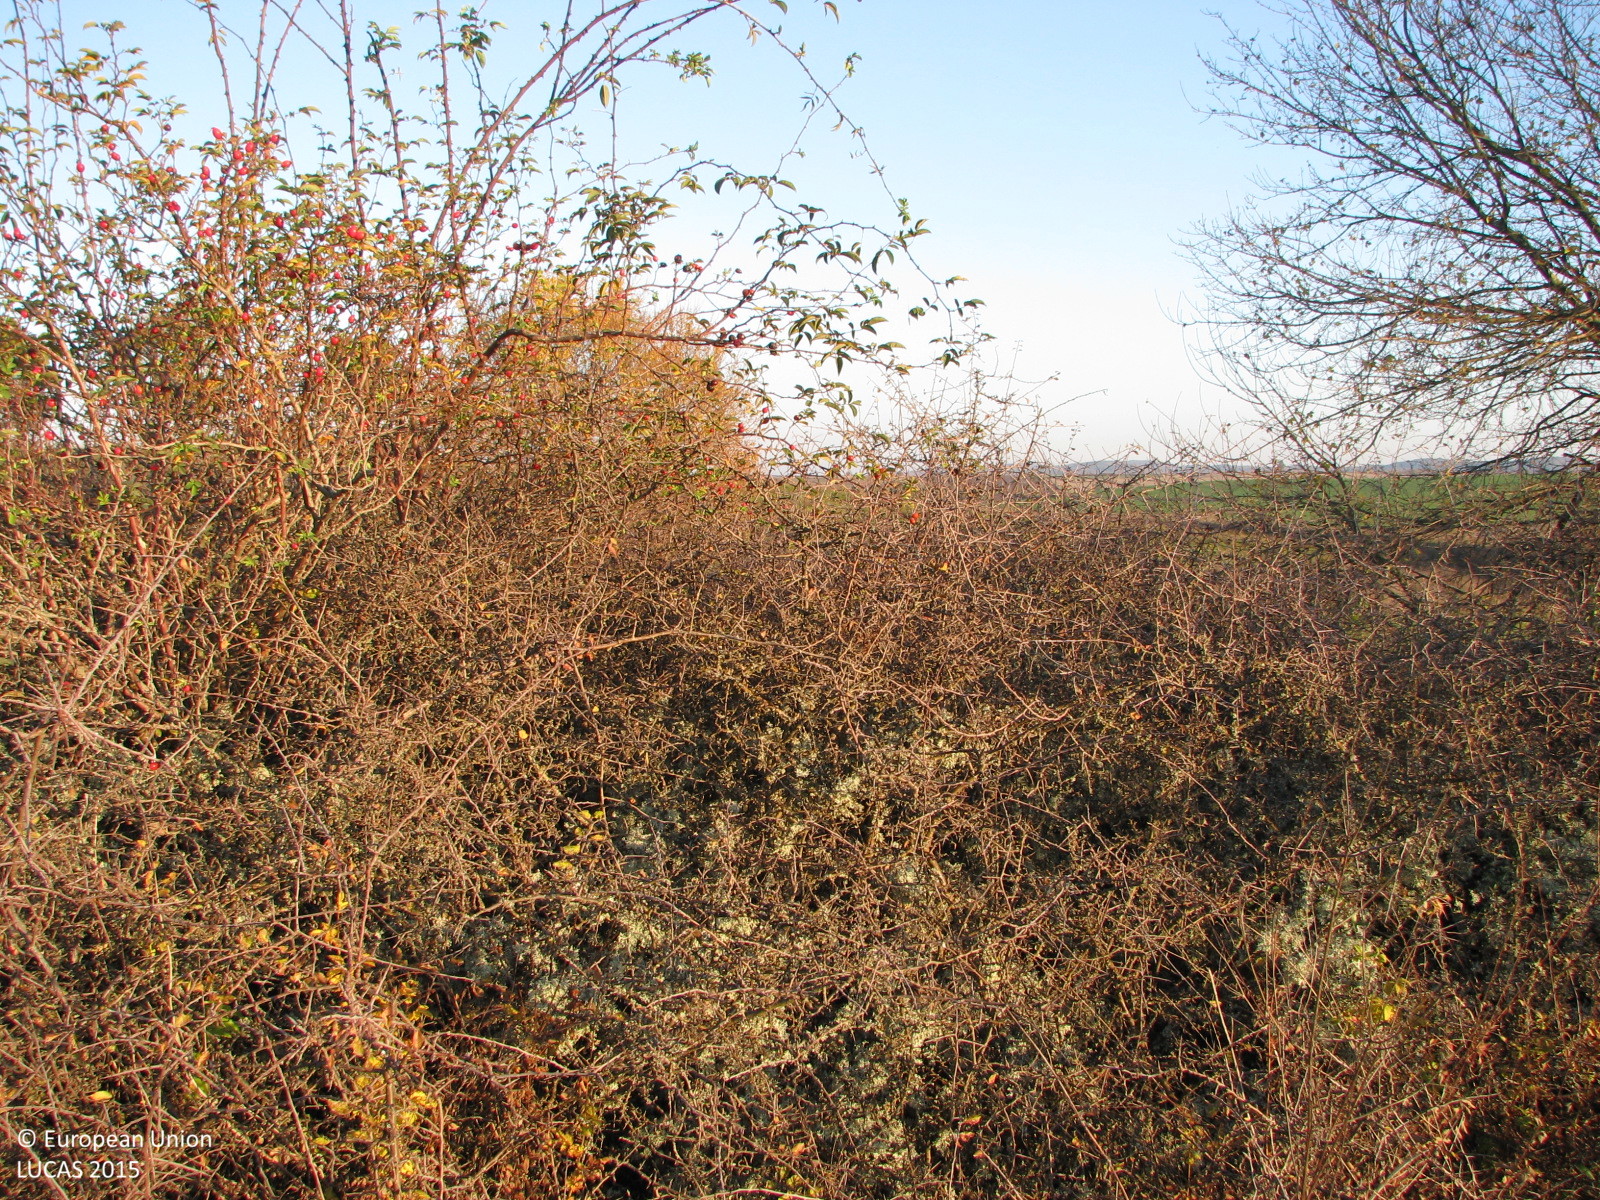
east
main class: Shrubland
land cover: Shrubland with sparse tree cover
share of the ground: 50 - 75 %
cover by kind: shrubs 70 %, herbaceous plants 25 %, broadleaved forest trees 5 %
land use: Semi-natural and natural areas not in use
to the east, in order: Shrubland with sparse tree cover; Grassland without tree/shrub cover; Single bushes/trees; Grassland without tree/shrub cover; Single bushes/trees
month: November
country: BG
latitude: 42.0579
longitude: 26.8552
